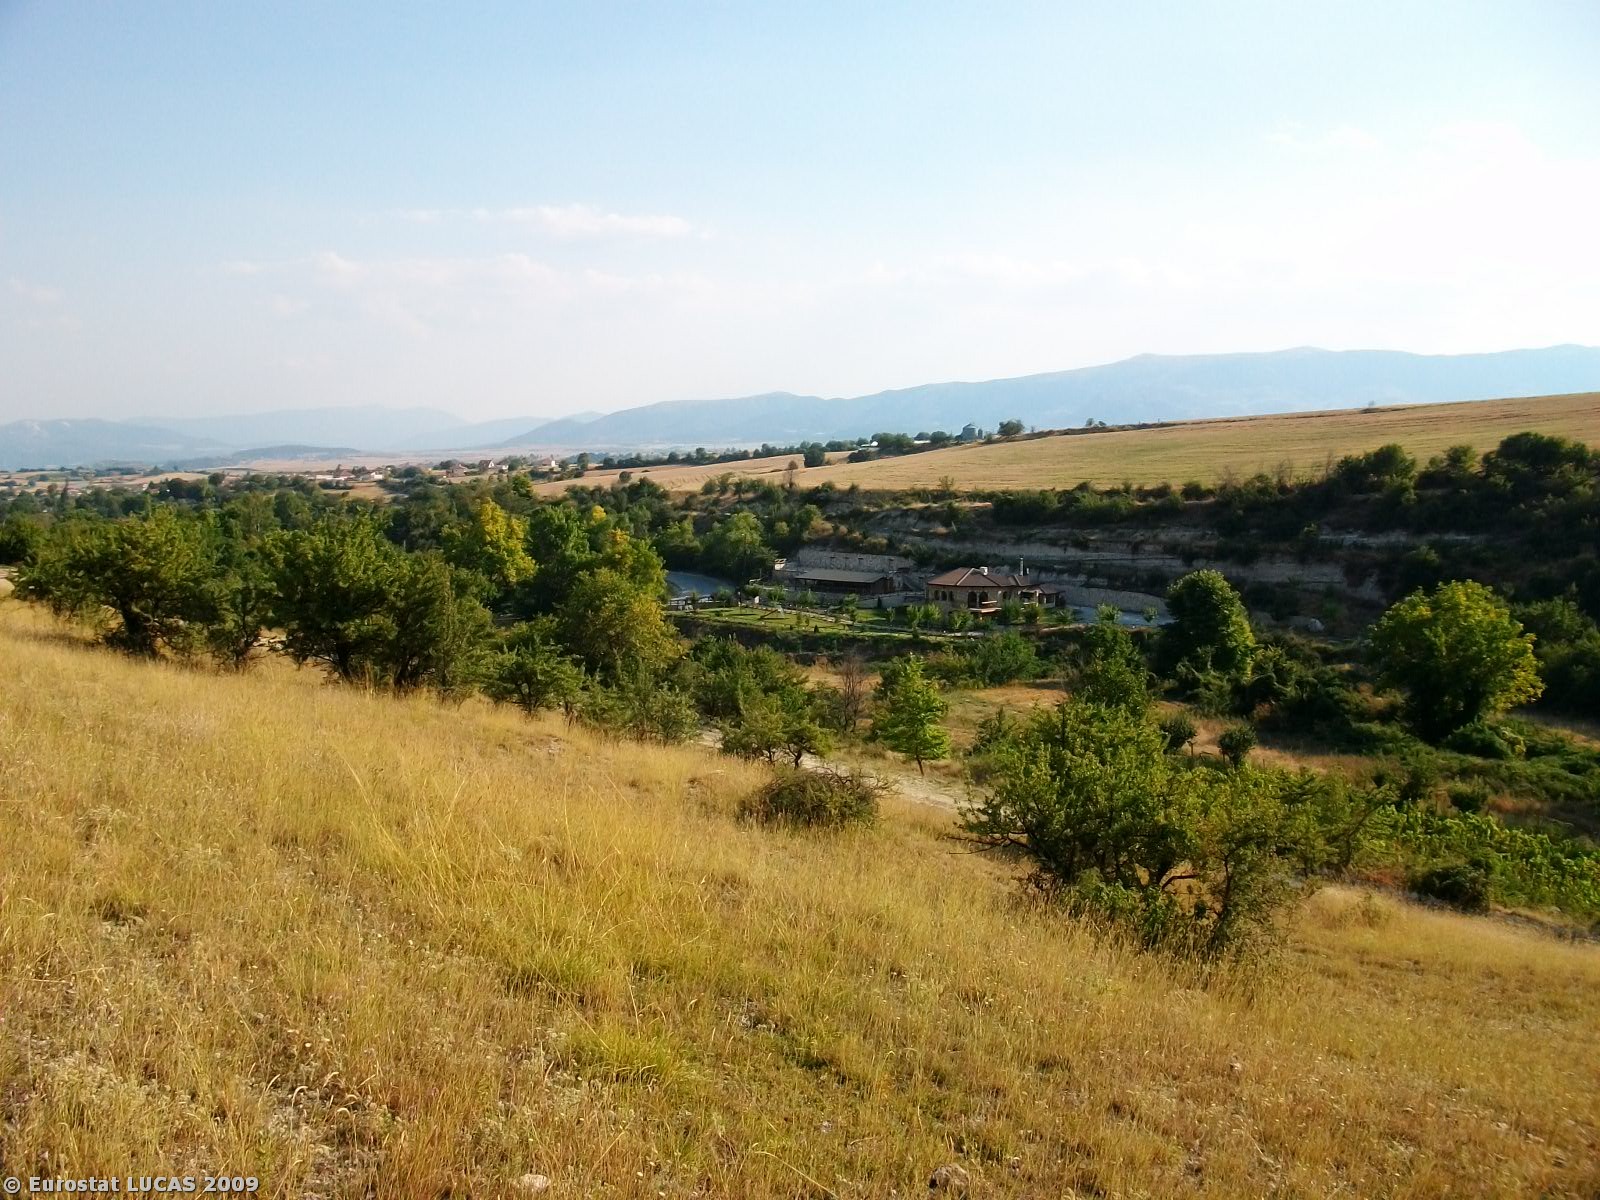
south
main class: Grassland
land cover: Grassland with sparse tree/shrub cover
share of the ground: > 75 %
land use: Unused
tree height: > 5 m
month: July
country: GR
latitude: 40.2431
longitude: 21.8289
